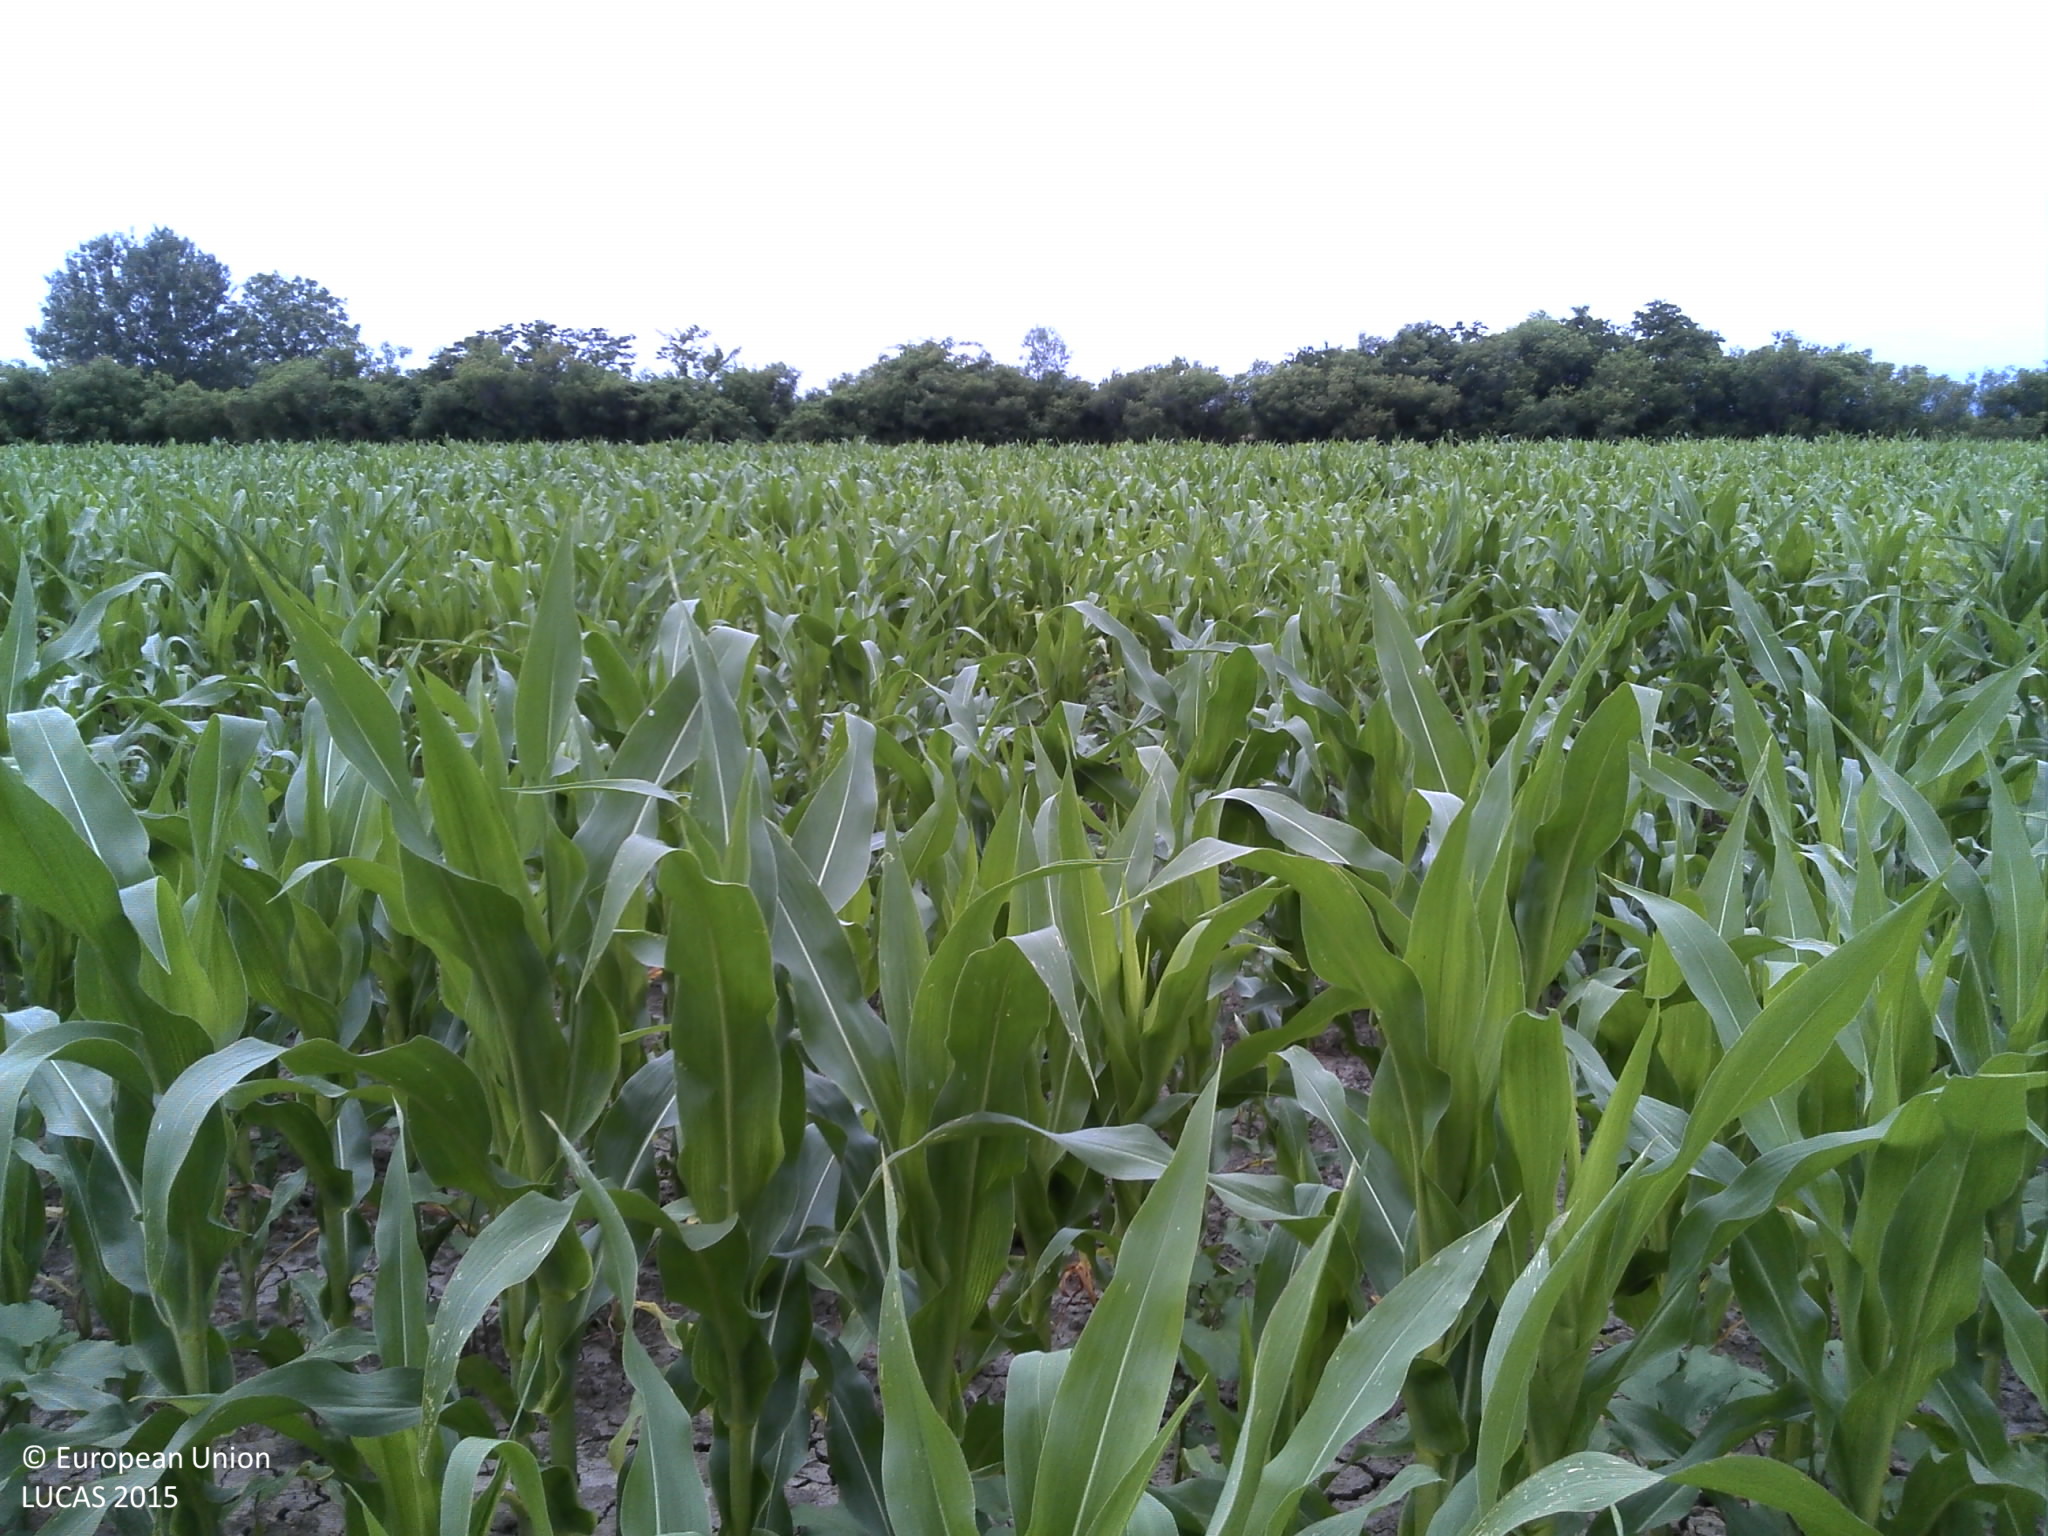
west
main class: Cropland
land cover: Maize
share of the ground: 50 - 75 %
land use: Agriculture (excluding fallow land and kitchen gardens)
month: June
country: HR
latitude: 45.1940
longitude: 17.5999
